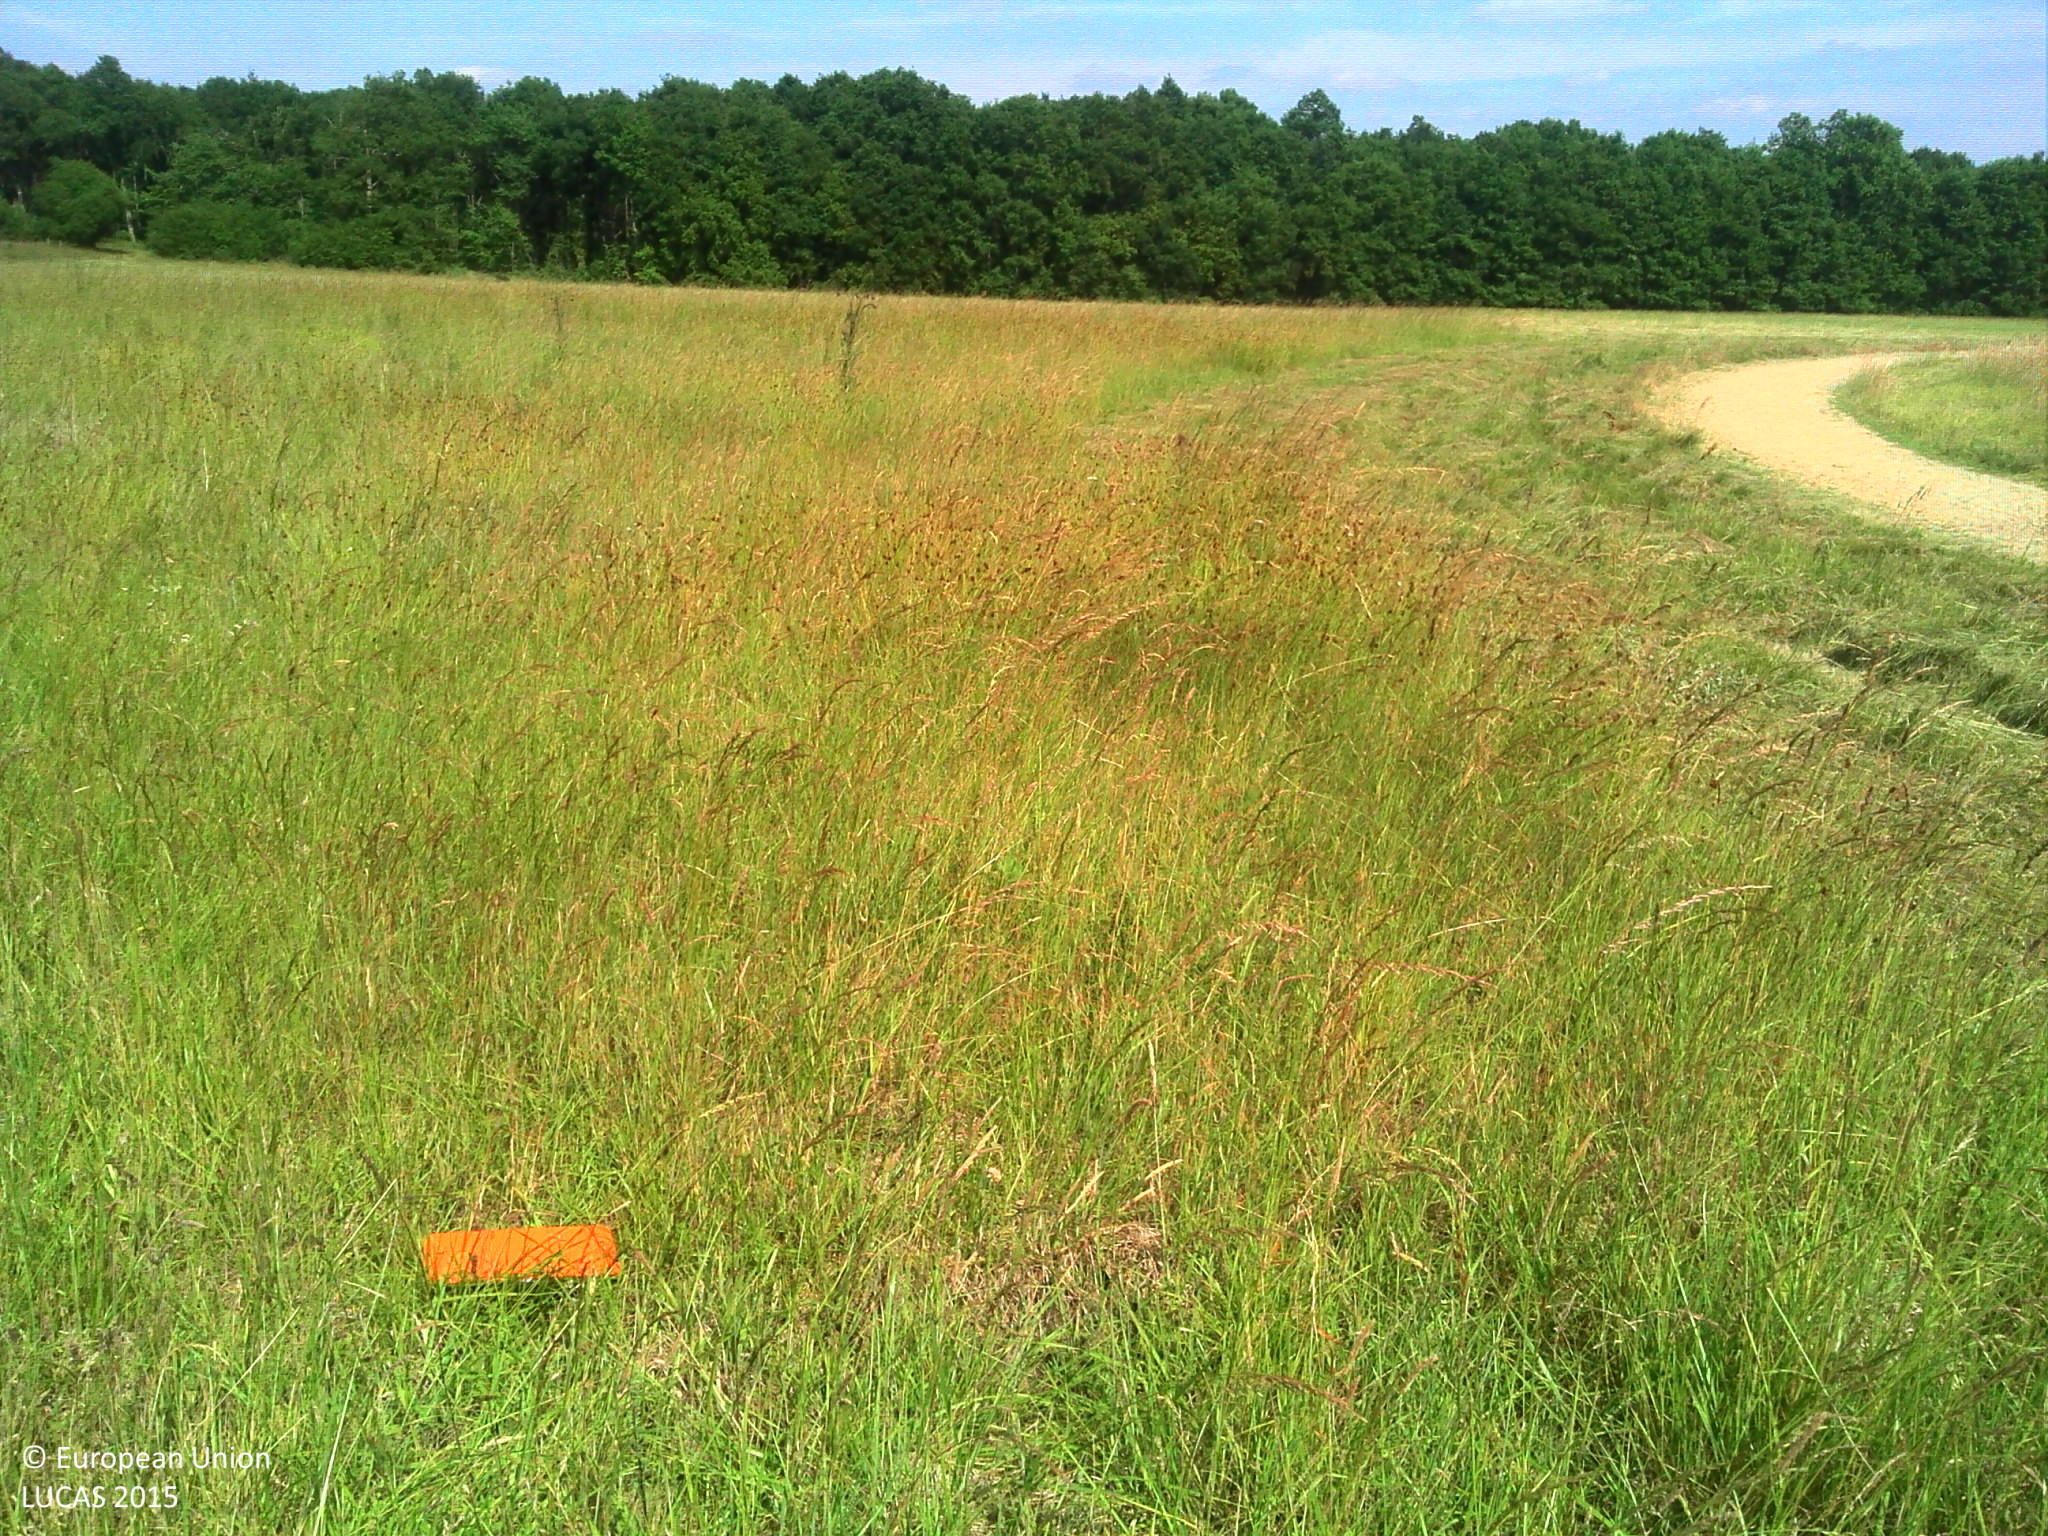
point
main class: Grassland
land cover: Grassland without tree/shrub cover
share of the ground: > 75 %
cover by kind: herbaceous plants 100 %
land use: Agriculture (excluding fallow land and kitchen gardens)
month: June
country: FR
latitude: 47.6105
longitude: 2.0473
